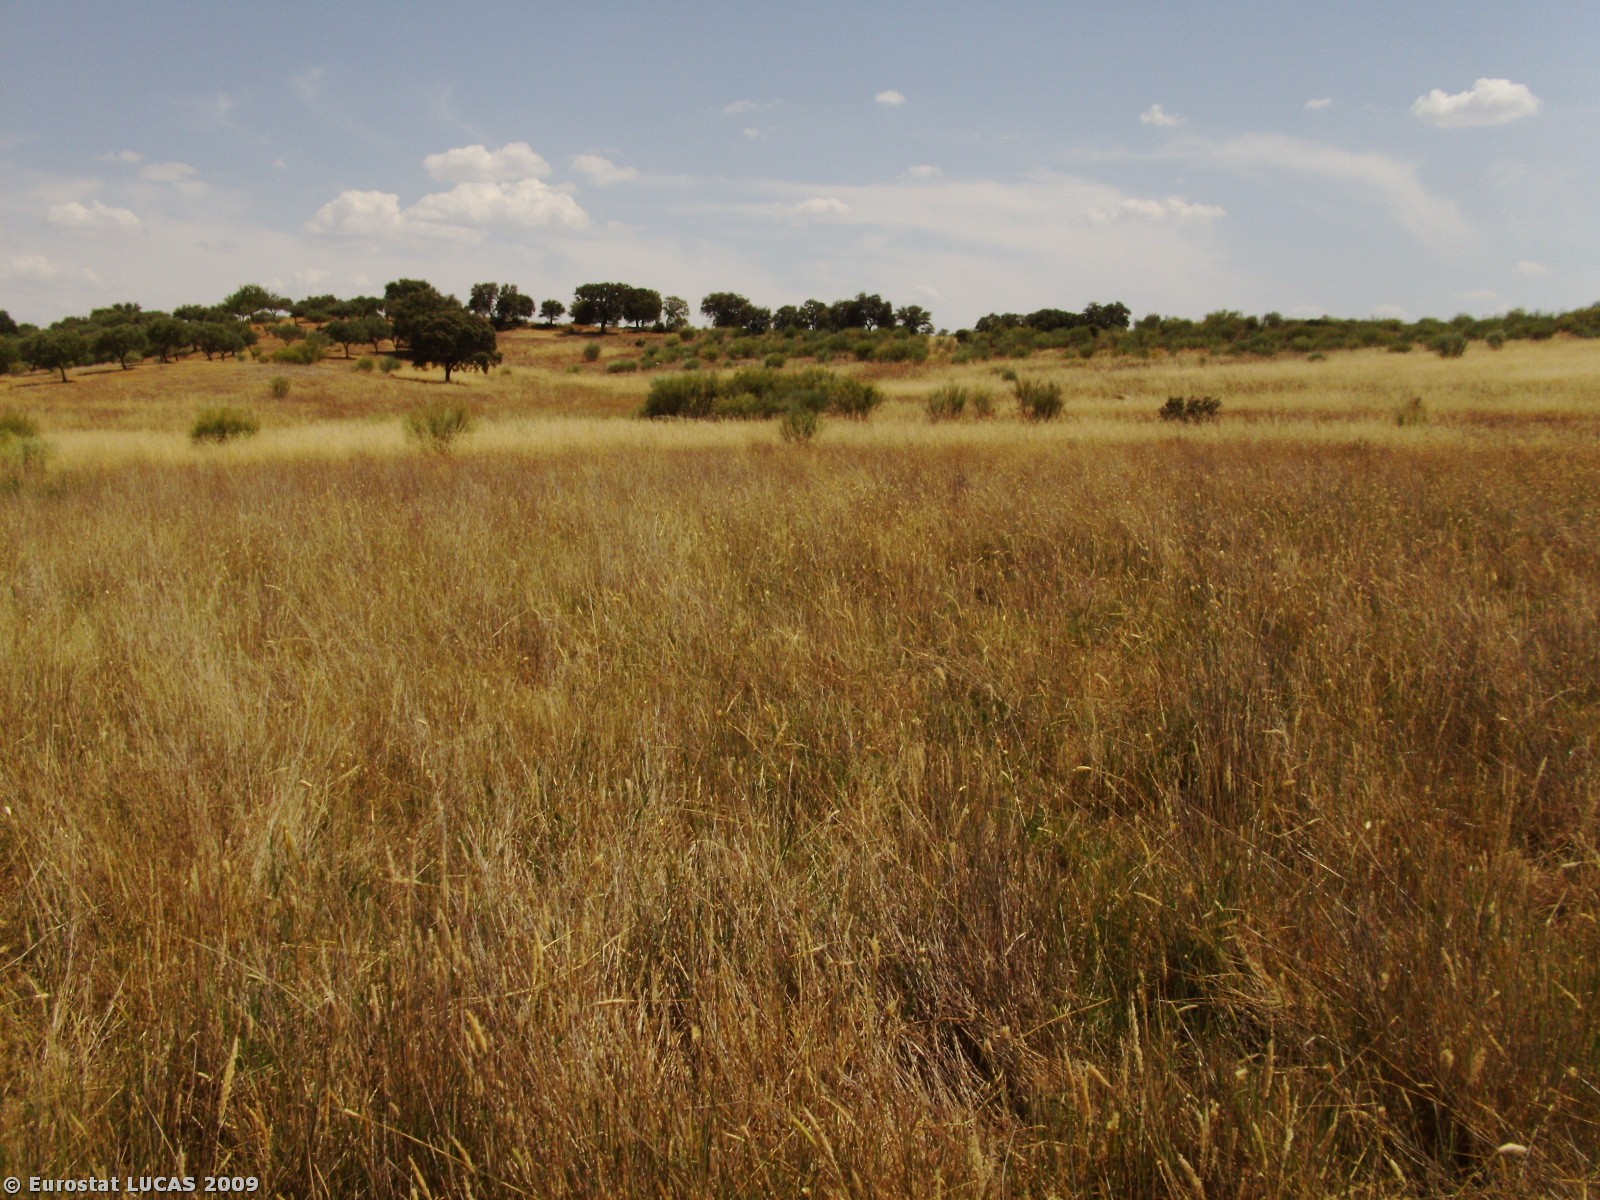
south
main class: Grassland
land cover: Spontaneously vegetated surfaces
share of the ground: > 75 %
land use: Fallow land
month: June
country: PT
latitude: 39.7737
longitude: -7.1708
